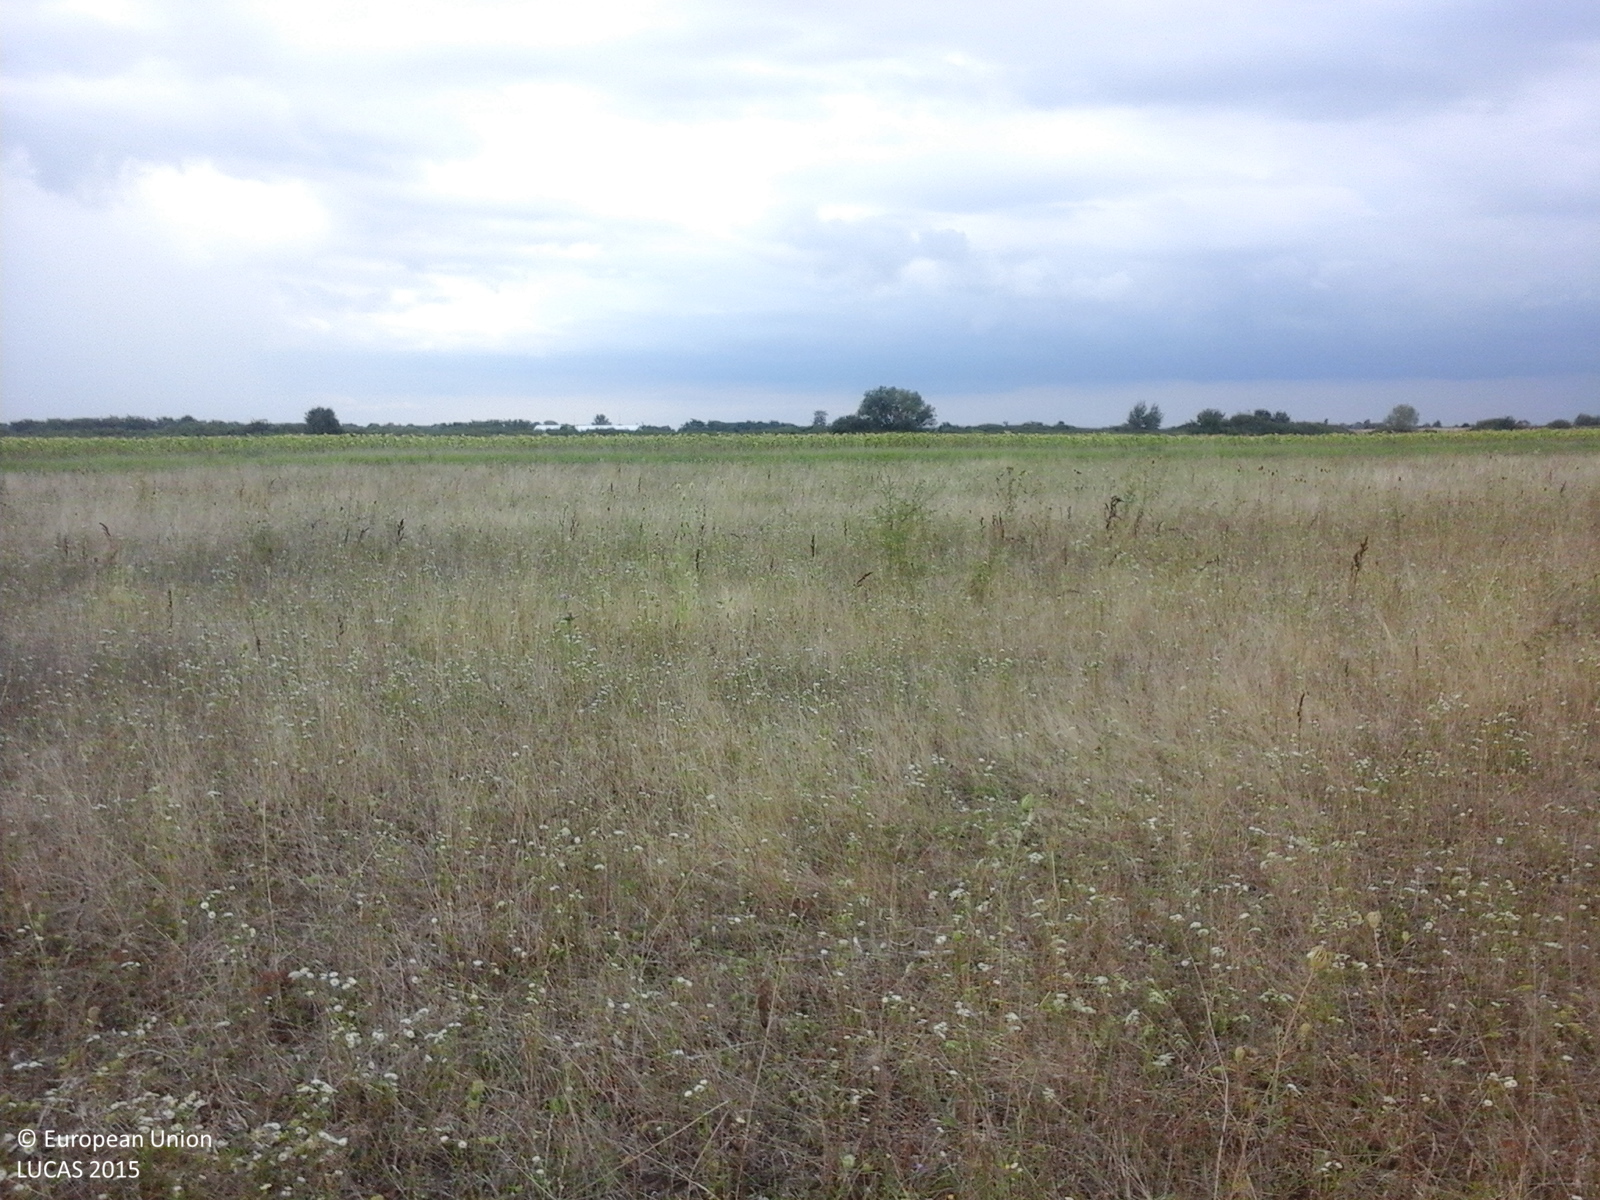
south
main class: Grassland
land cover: Grassland without tree/shrub cover
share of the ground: > 75 %
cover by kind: herbaceous plants 100 %
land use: Agriculture (excluding fallow land and kitchen gardens)
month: August
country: RO
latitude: 45.6772
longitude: 21.4716
